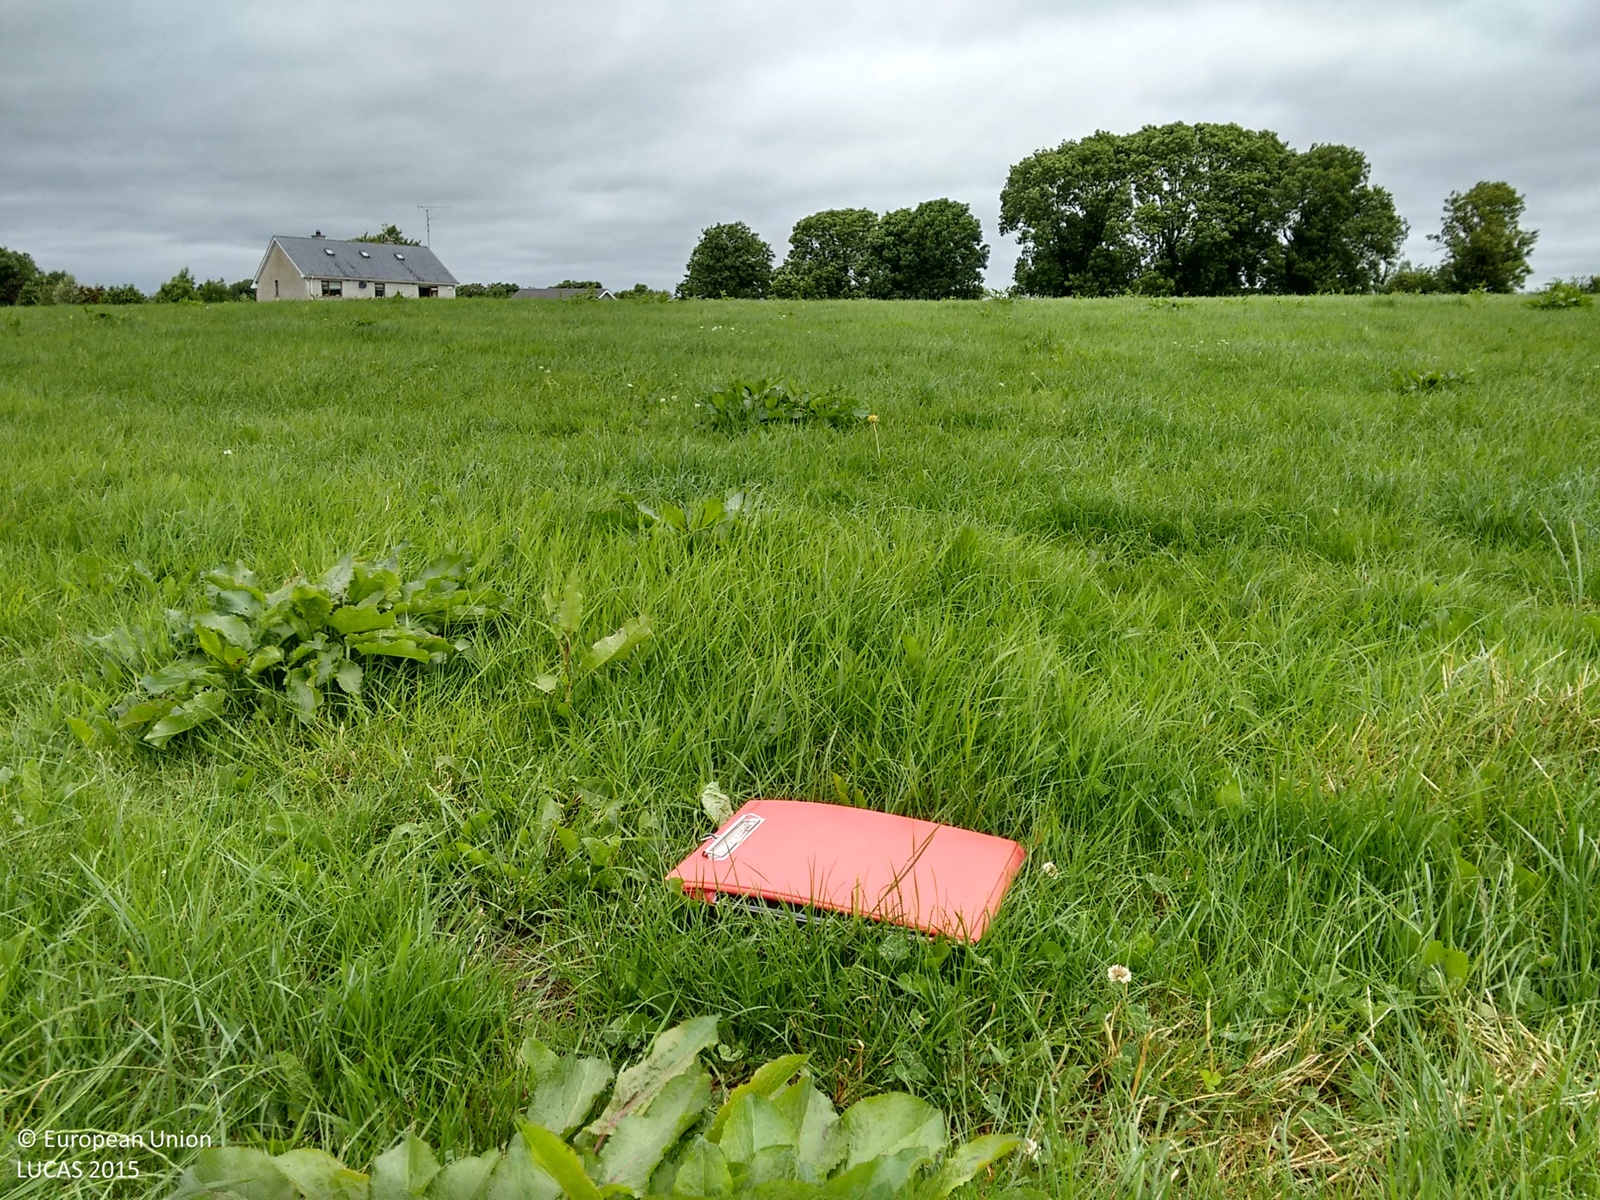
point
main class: Grassland
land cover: Grassland without tree/shrub cover
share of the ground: > 75 %
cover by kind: herbaceous plants 100 %
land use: Agriculture (excluding fallow land and kitchen gardens)
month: July
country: IE
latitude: 53.5138
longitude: -6.9861
